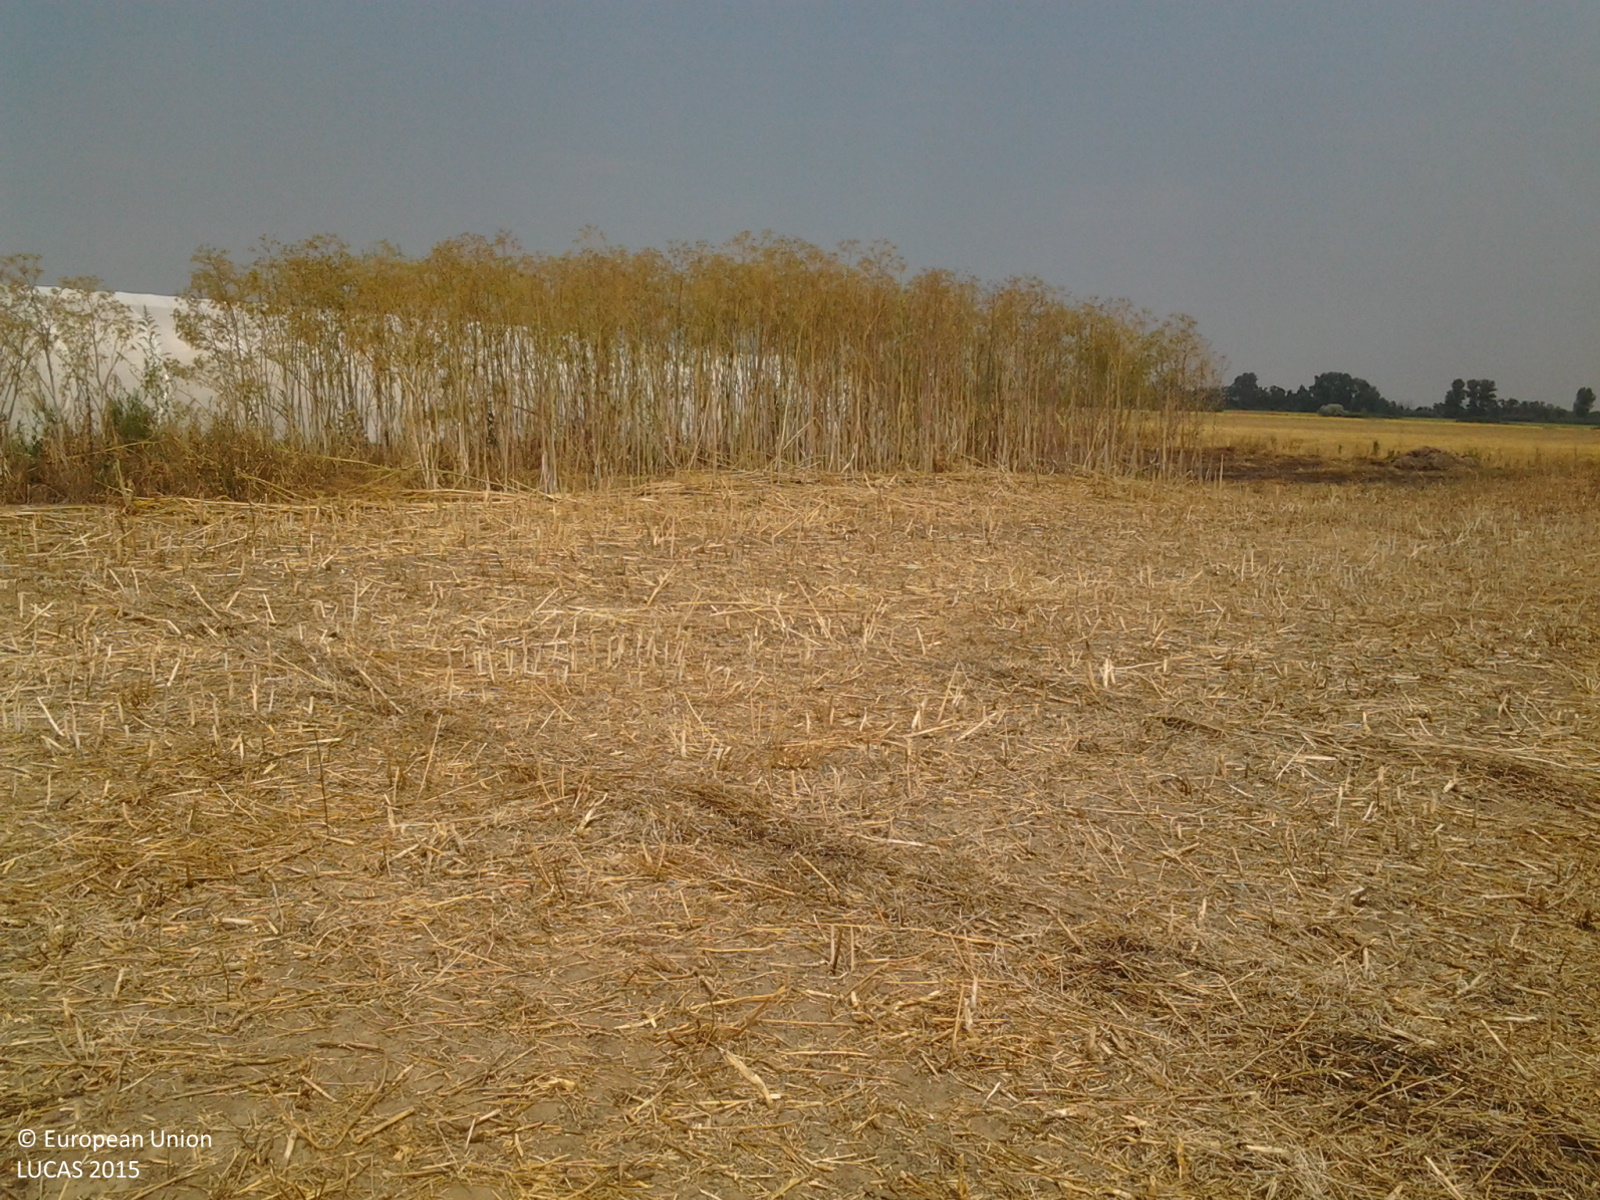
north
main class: Cropland
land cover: Rape and turnip rape
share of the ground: < 10 %
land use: Agriculture (excluding fallow land and kitchen gardens)
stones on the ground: < 10 %
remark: Harvested field
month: July
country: HU
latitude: 46.7683
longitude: 21.4705
